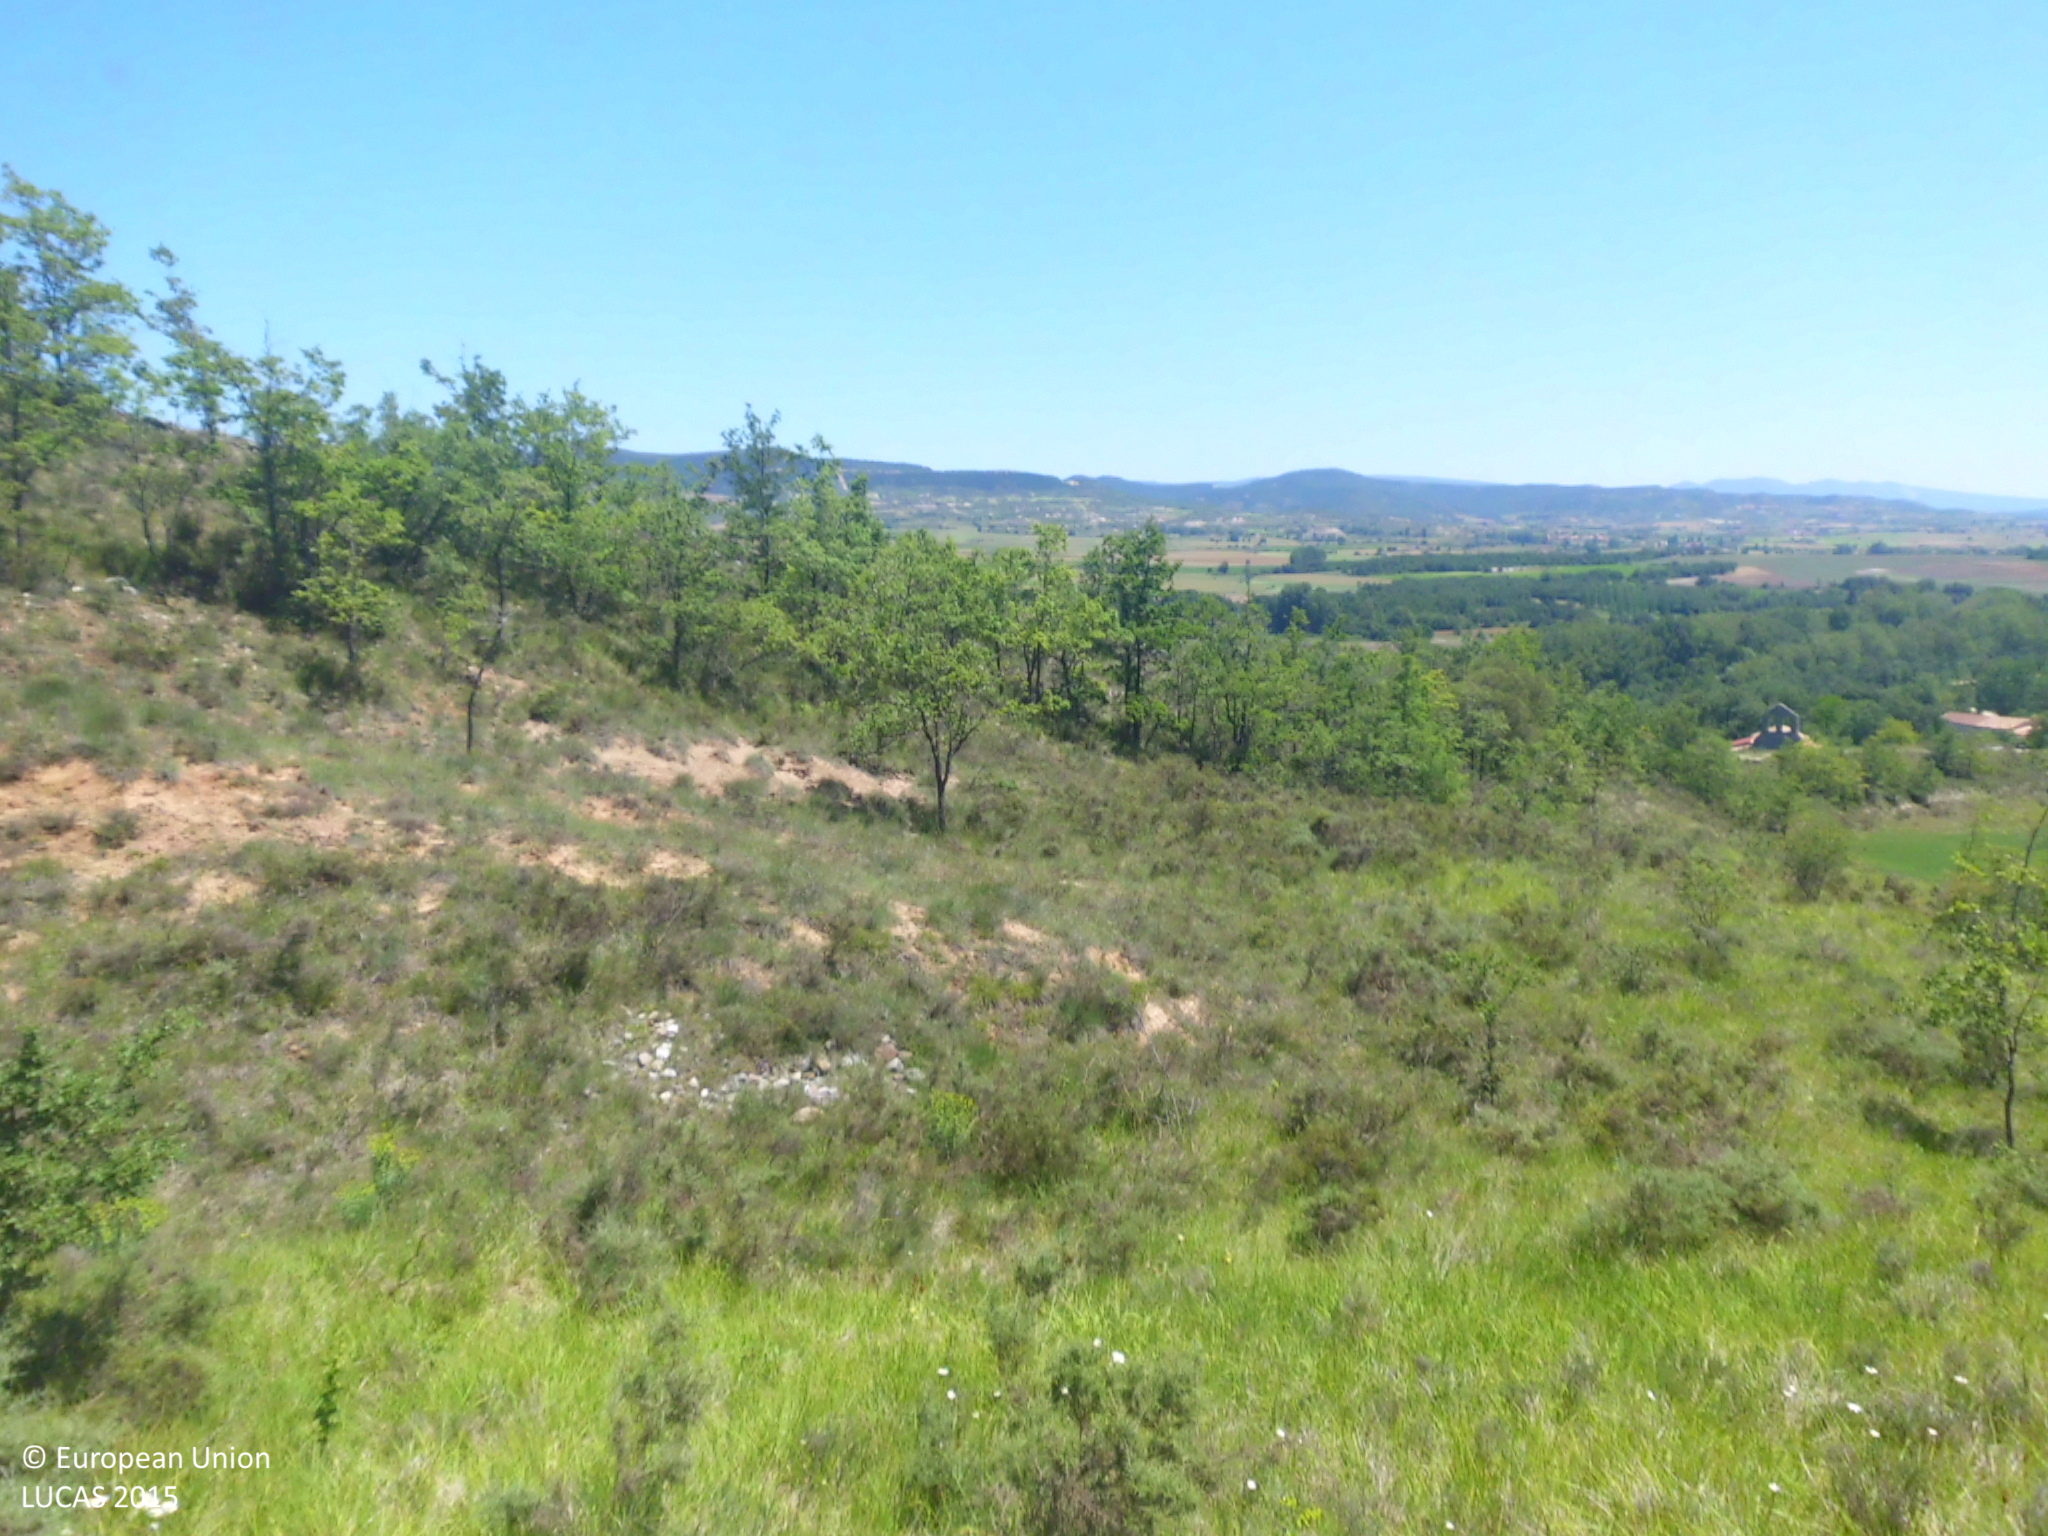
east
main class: Grassland
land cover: Grassland with sparse tree/shrub cover
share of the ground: > 75 %
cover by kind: herbaceous plants 90 %, broadleaved forest trees 5 %, shrubs 5 %
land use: Abandoned areas
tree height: < 5 m
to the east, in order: Grassland with sparse tree/shrub cover; Tracks; Grassland with sparse tree/shrub cover; Common wheat; Broadleaved woodland; Tracks
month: June
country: ES
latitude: 42.8654
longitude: -3.4654
